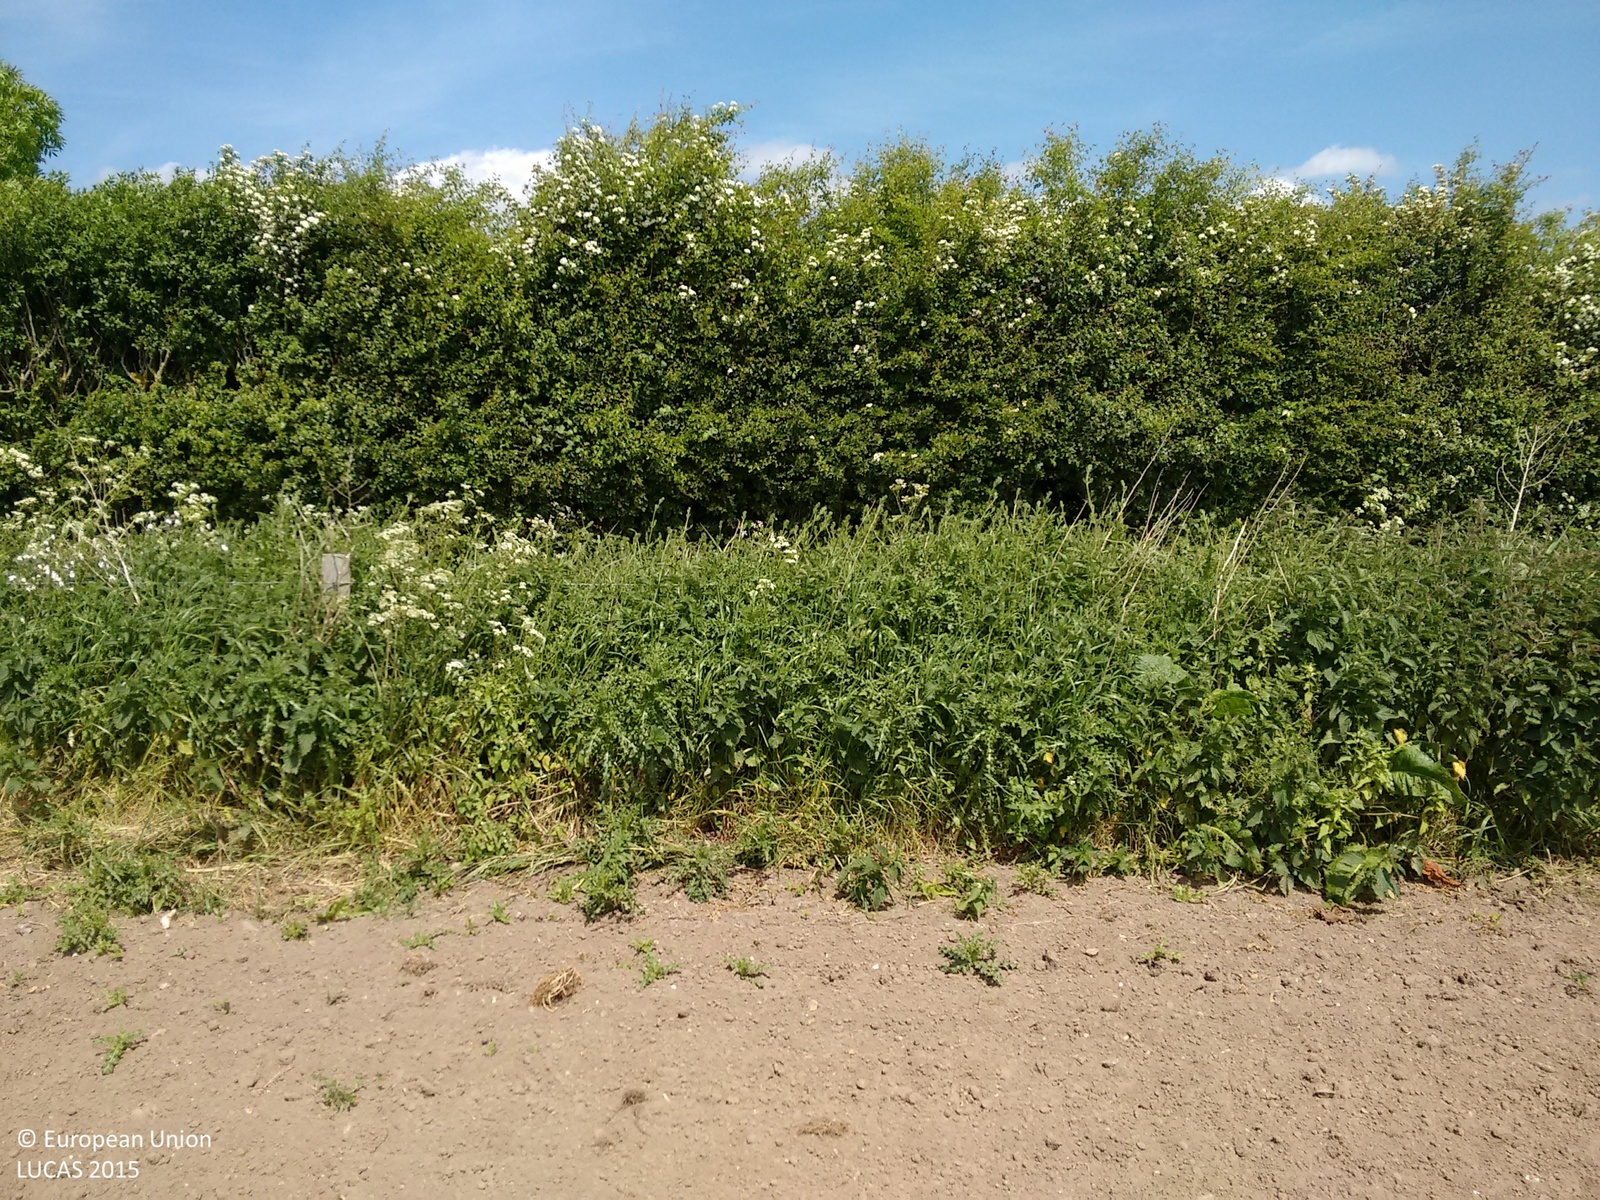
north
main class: Cropland
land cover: Common wheat
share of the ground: > 75 %
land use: Agriculture (excluding fallow land and kitchen gardens)
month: May
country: GB
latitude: 50.8760
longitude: -1.0880
